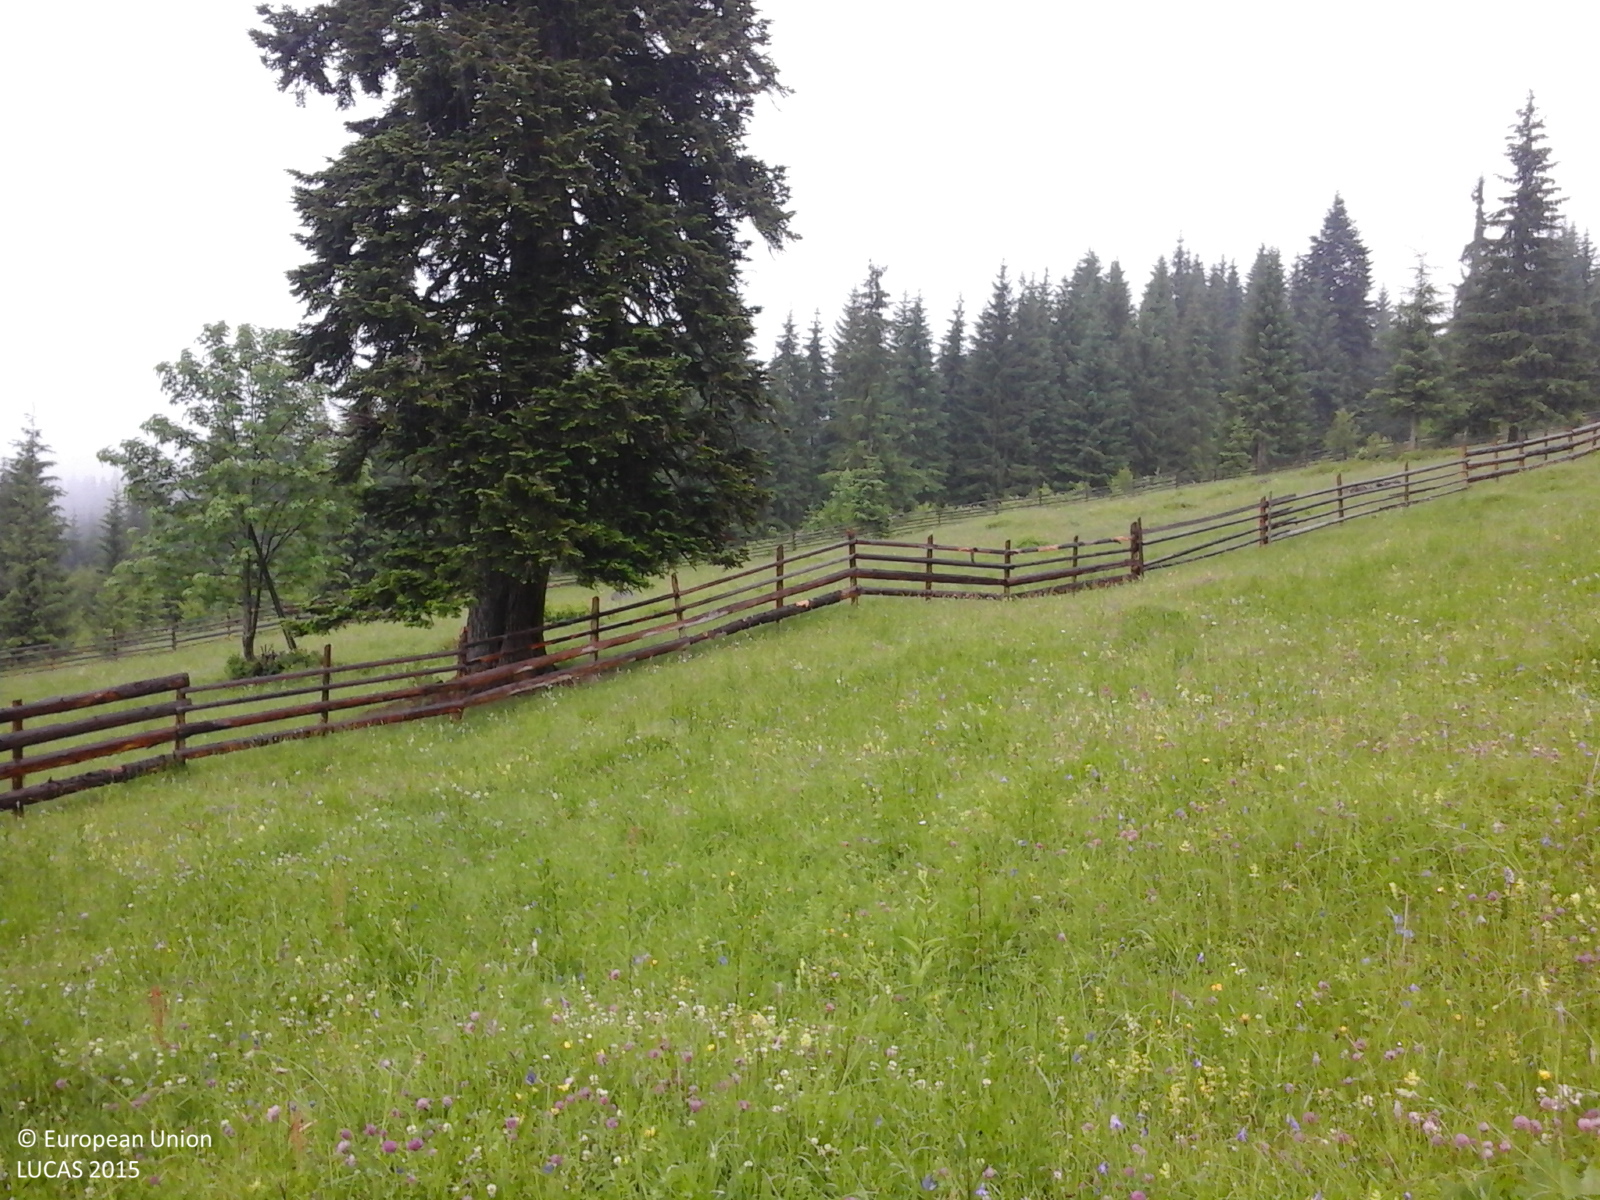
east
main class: Grassland
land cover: Grassland without tree/shrub cover
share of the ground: > 75 %
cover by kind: herbaceous plants 100 %
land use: Agriculture (excluding fallow land and kitchen gardens)
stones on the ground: < 10 %
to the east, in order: Grassland without tree/shrub cover; Fences; Grassland without tree/shrub cover; Single bushes/trees; Grassland without tree/shrub cover; Fences; Lines of trees; Grassland with sparse tree/shrub cover; Shrubland with sparse tree cover; Grassland without tree/shrub cover; Broadleaved woodland; Fences; Grassland with sparse tree/shrub cover; Broadleaved woodland; Grassland with sparse tree/shrub cover; Broadleaved woodland; Fences; Broadleaved woodland; Grassland with sparse tree/shrub cover
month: June
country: RO
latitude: 47.2156
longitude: 25.3346
